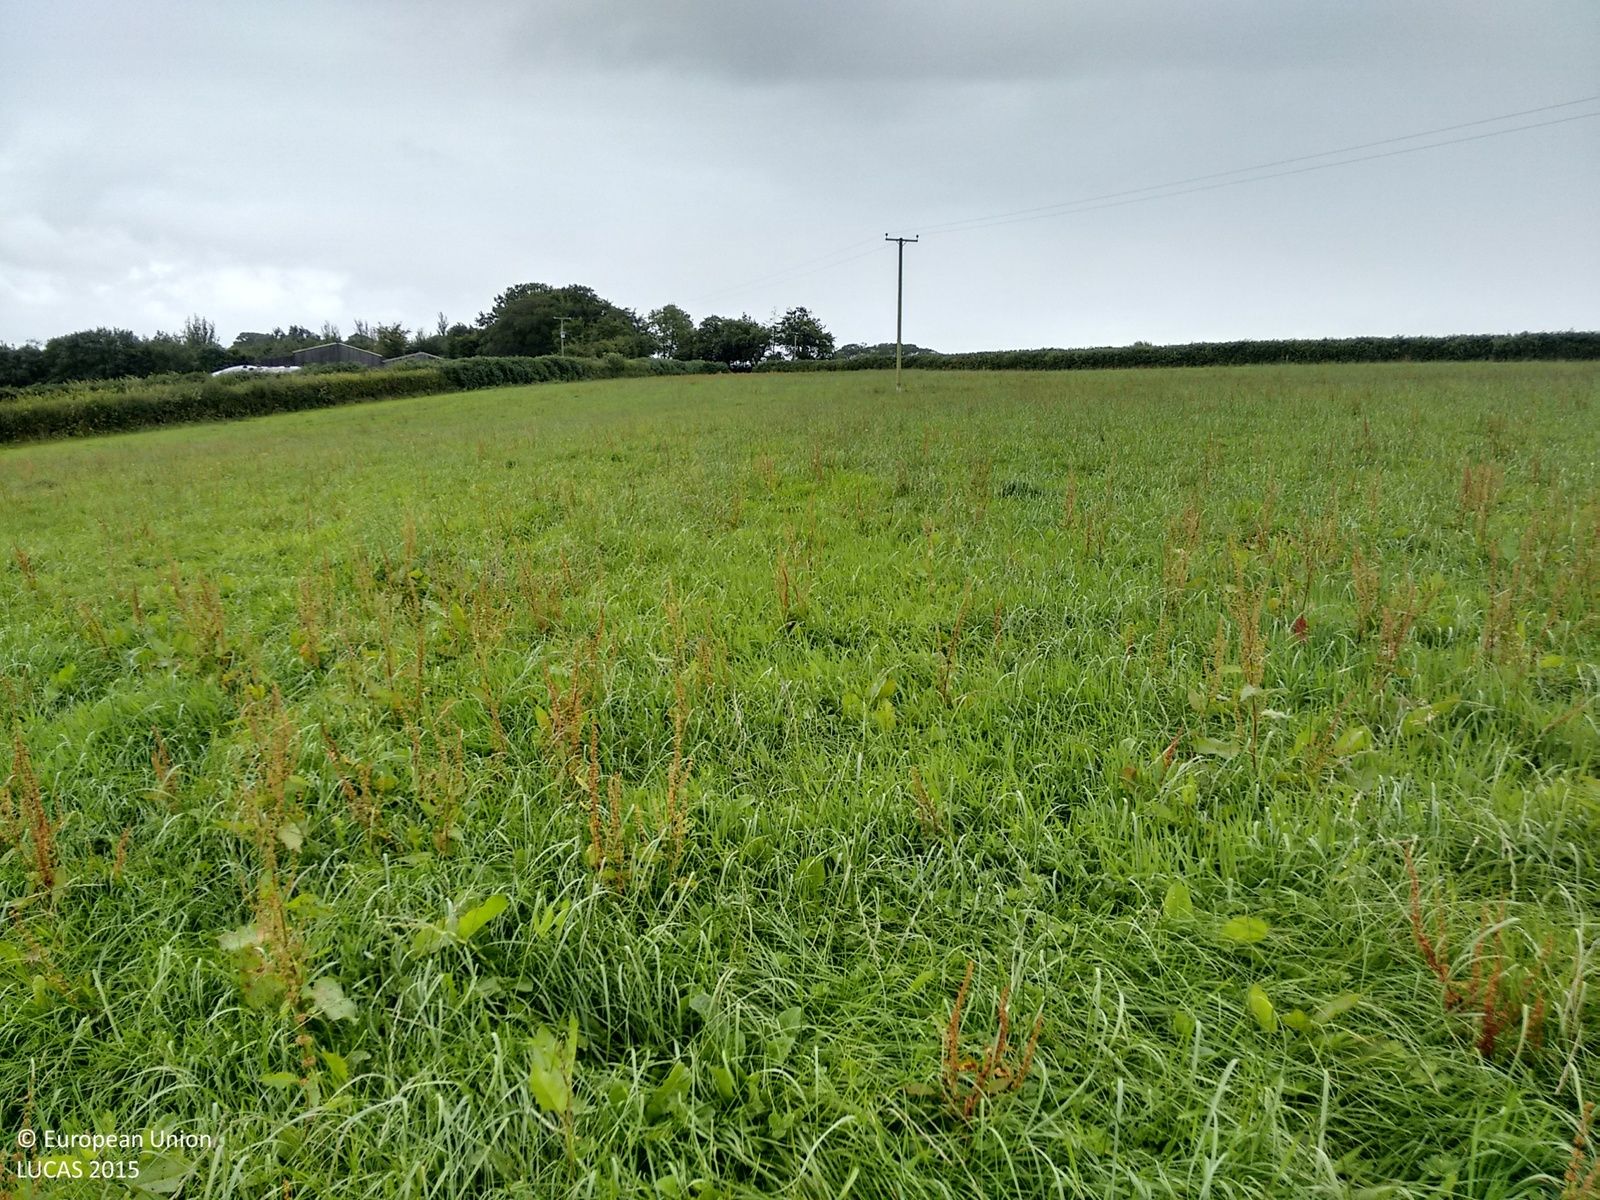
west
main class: Grassland
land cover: Grassland without tree/shrub cover
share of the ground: > 75 %
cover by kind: herbaceous plants 100 %
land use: Agriculture (excluding fallow land and kitchen gardens)
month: September
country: GB
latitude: 50.9286
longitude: -3.7913
